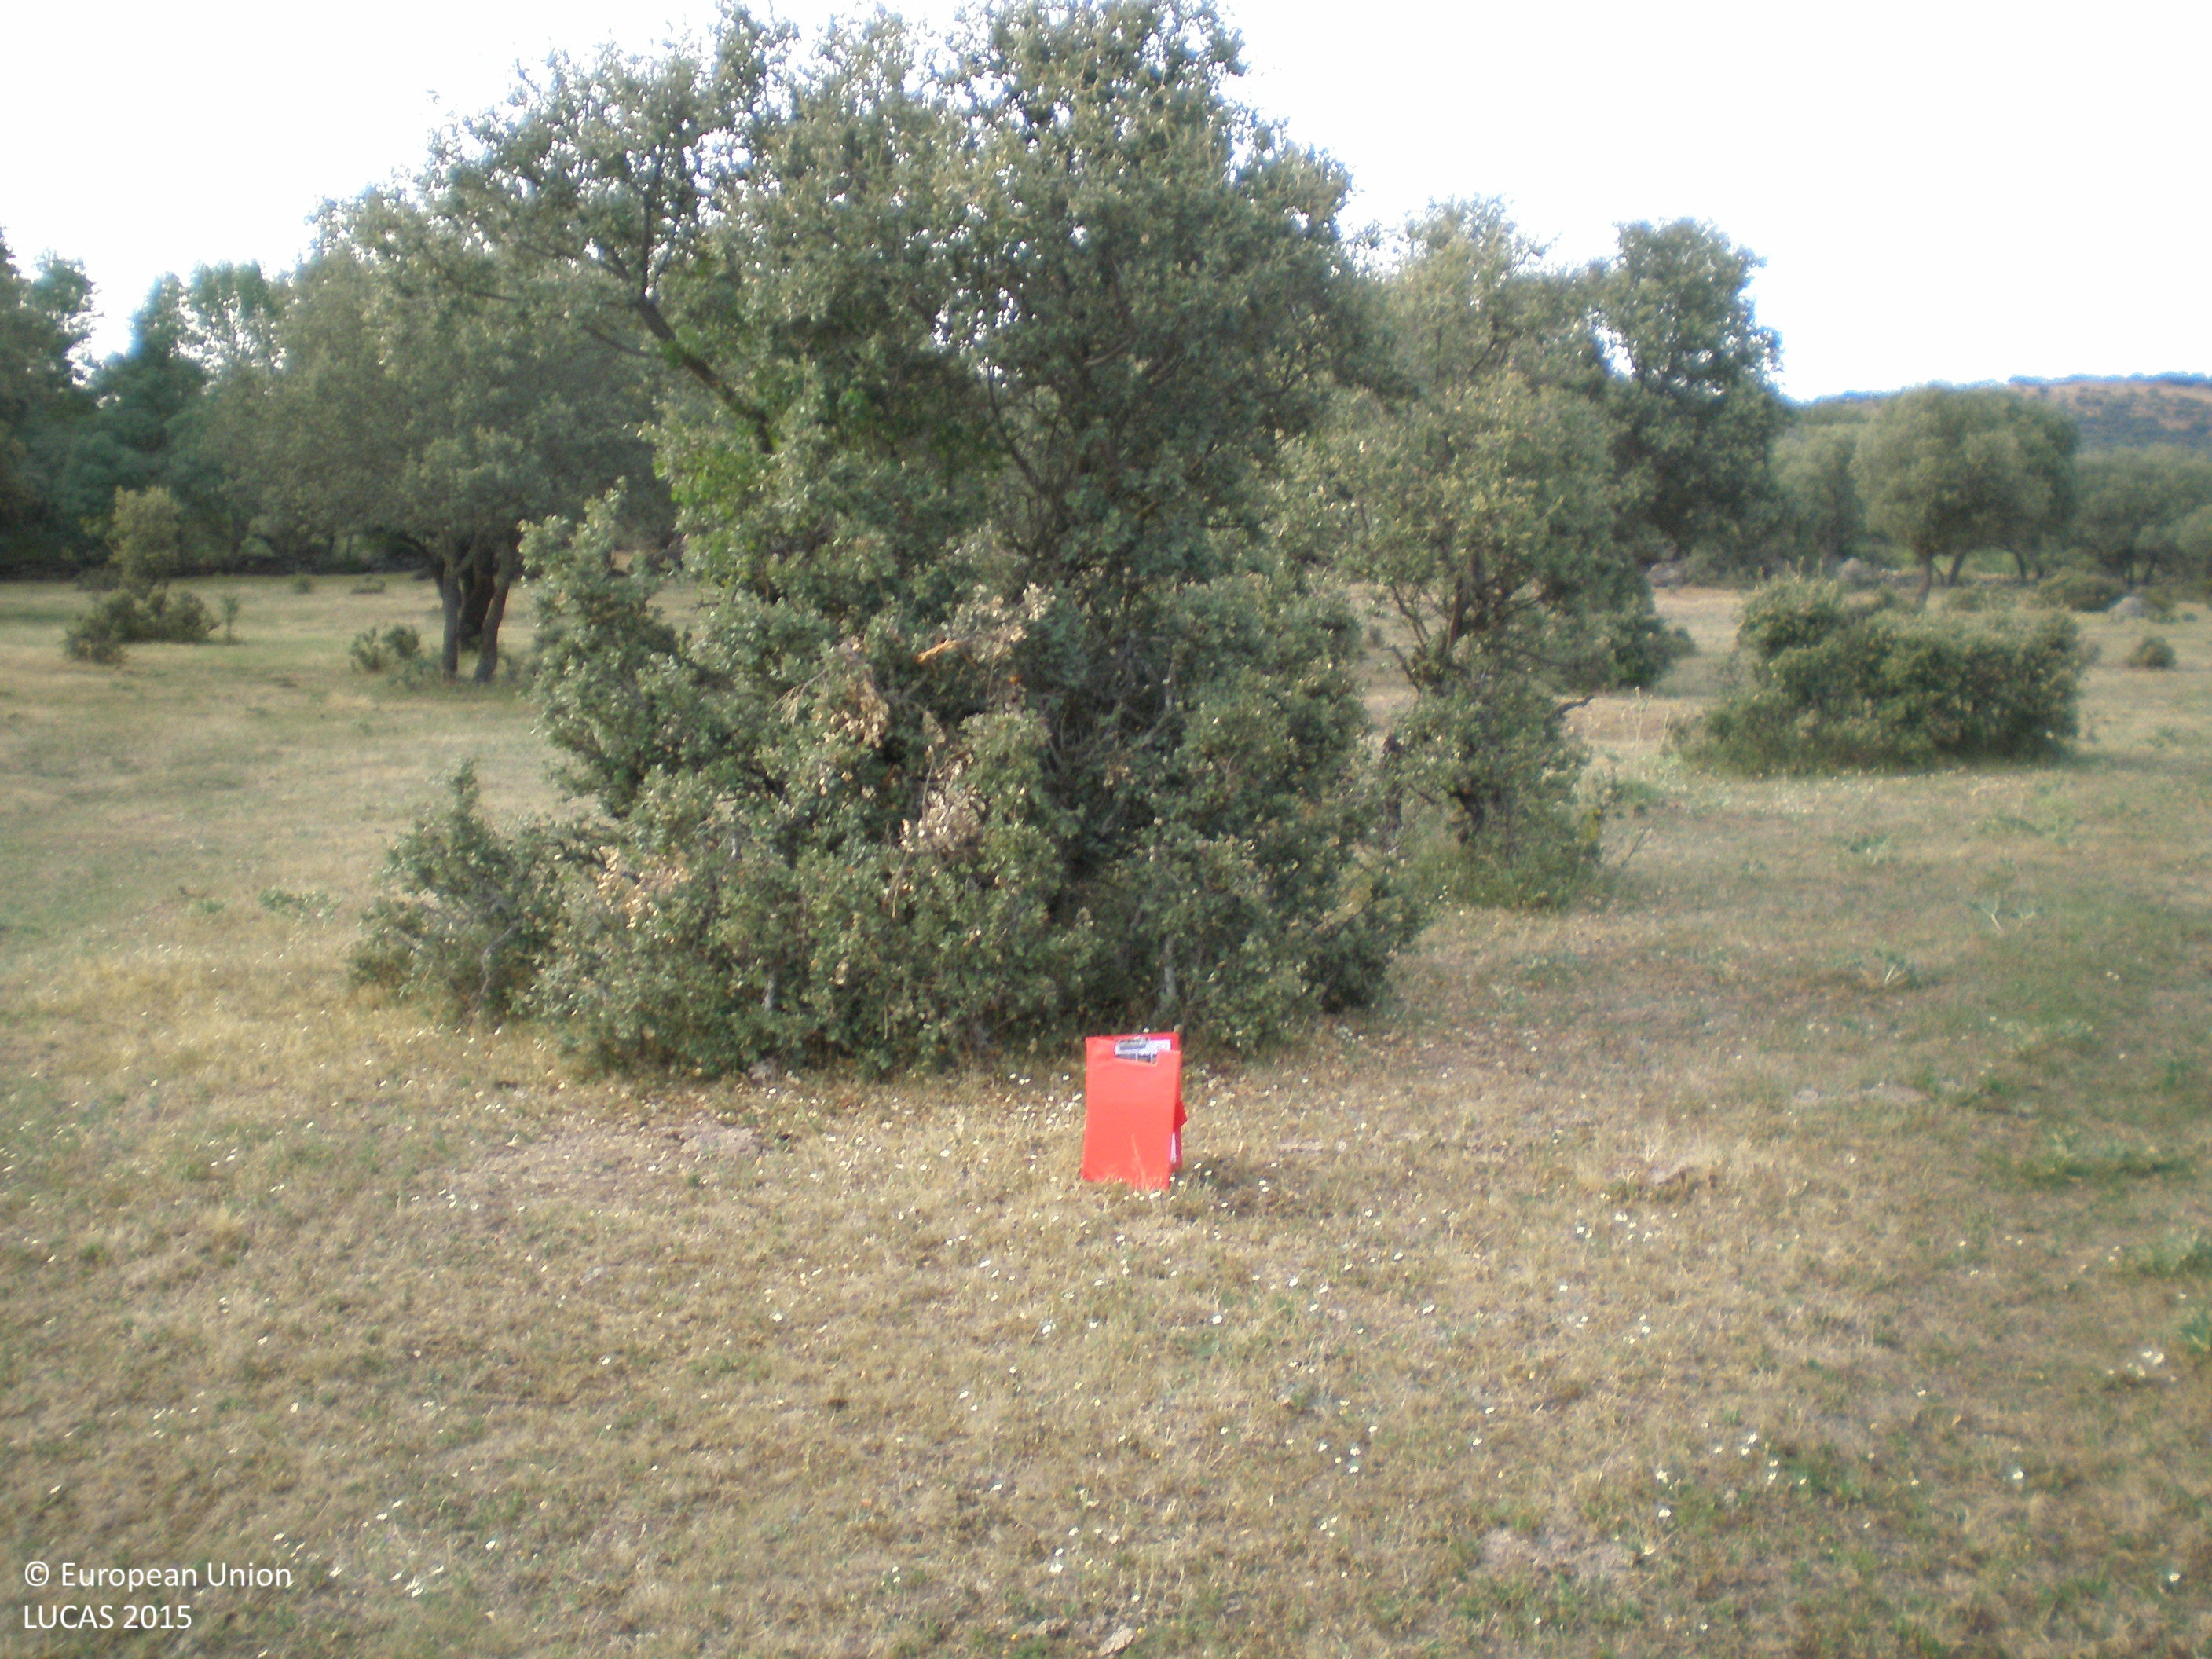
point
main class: Grassland
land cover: Grassland with sparse tree/shrub cover
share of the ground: > 75 %
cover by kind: herbaceous plants 95 %, broadleaved forest trees 5 %
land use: Agriculture (excluding fallow land and kitchen gardens)
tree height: < 5 m
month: July
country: ES
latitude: 40.5160
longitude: -5.6137
